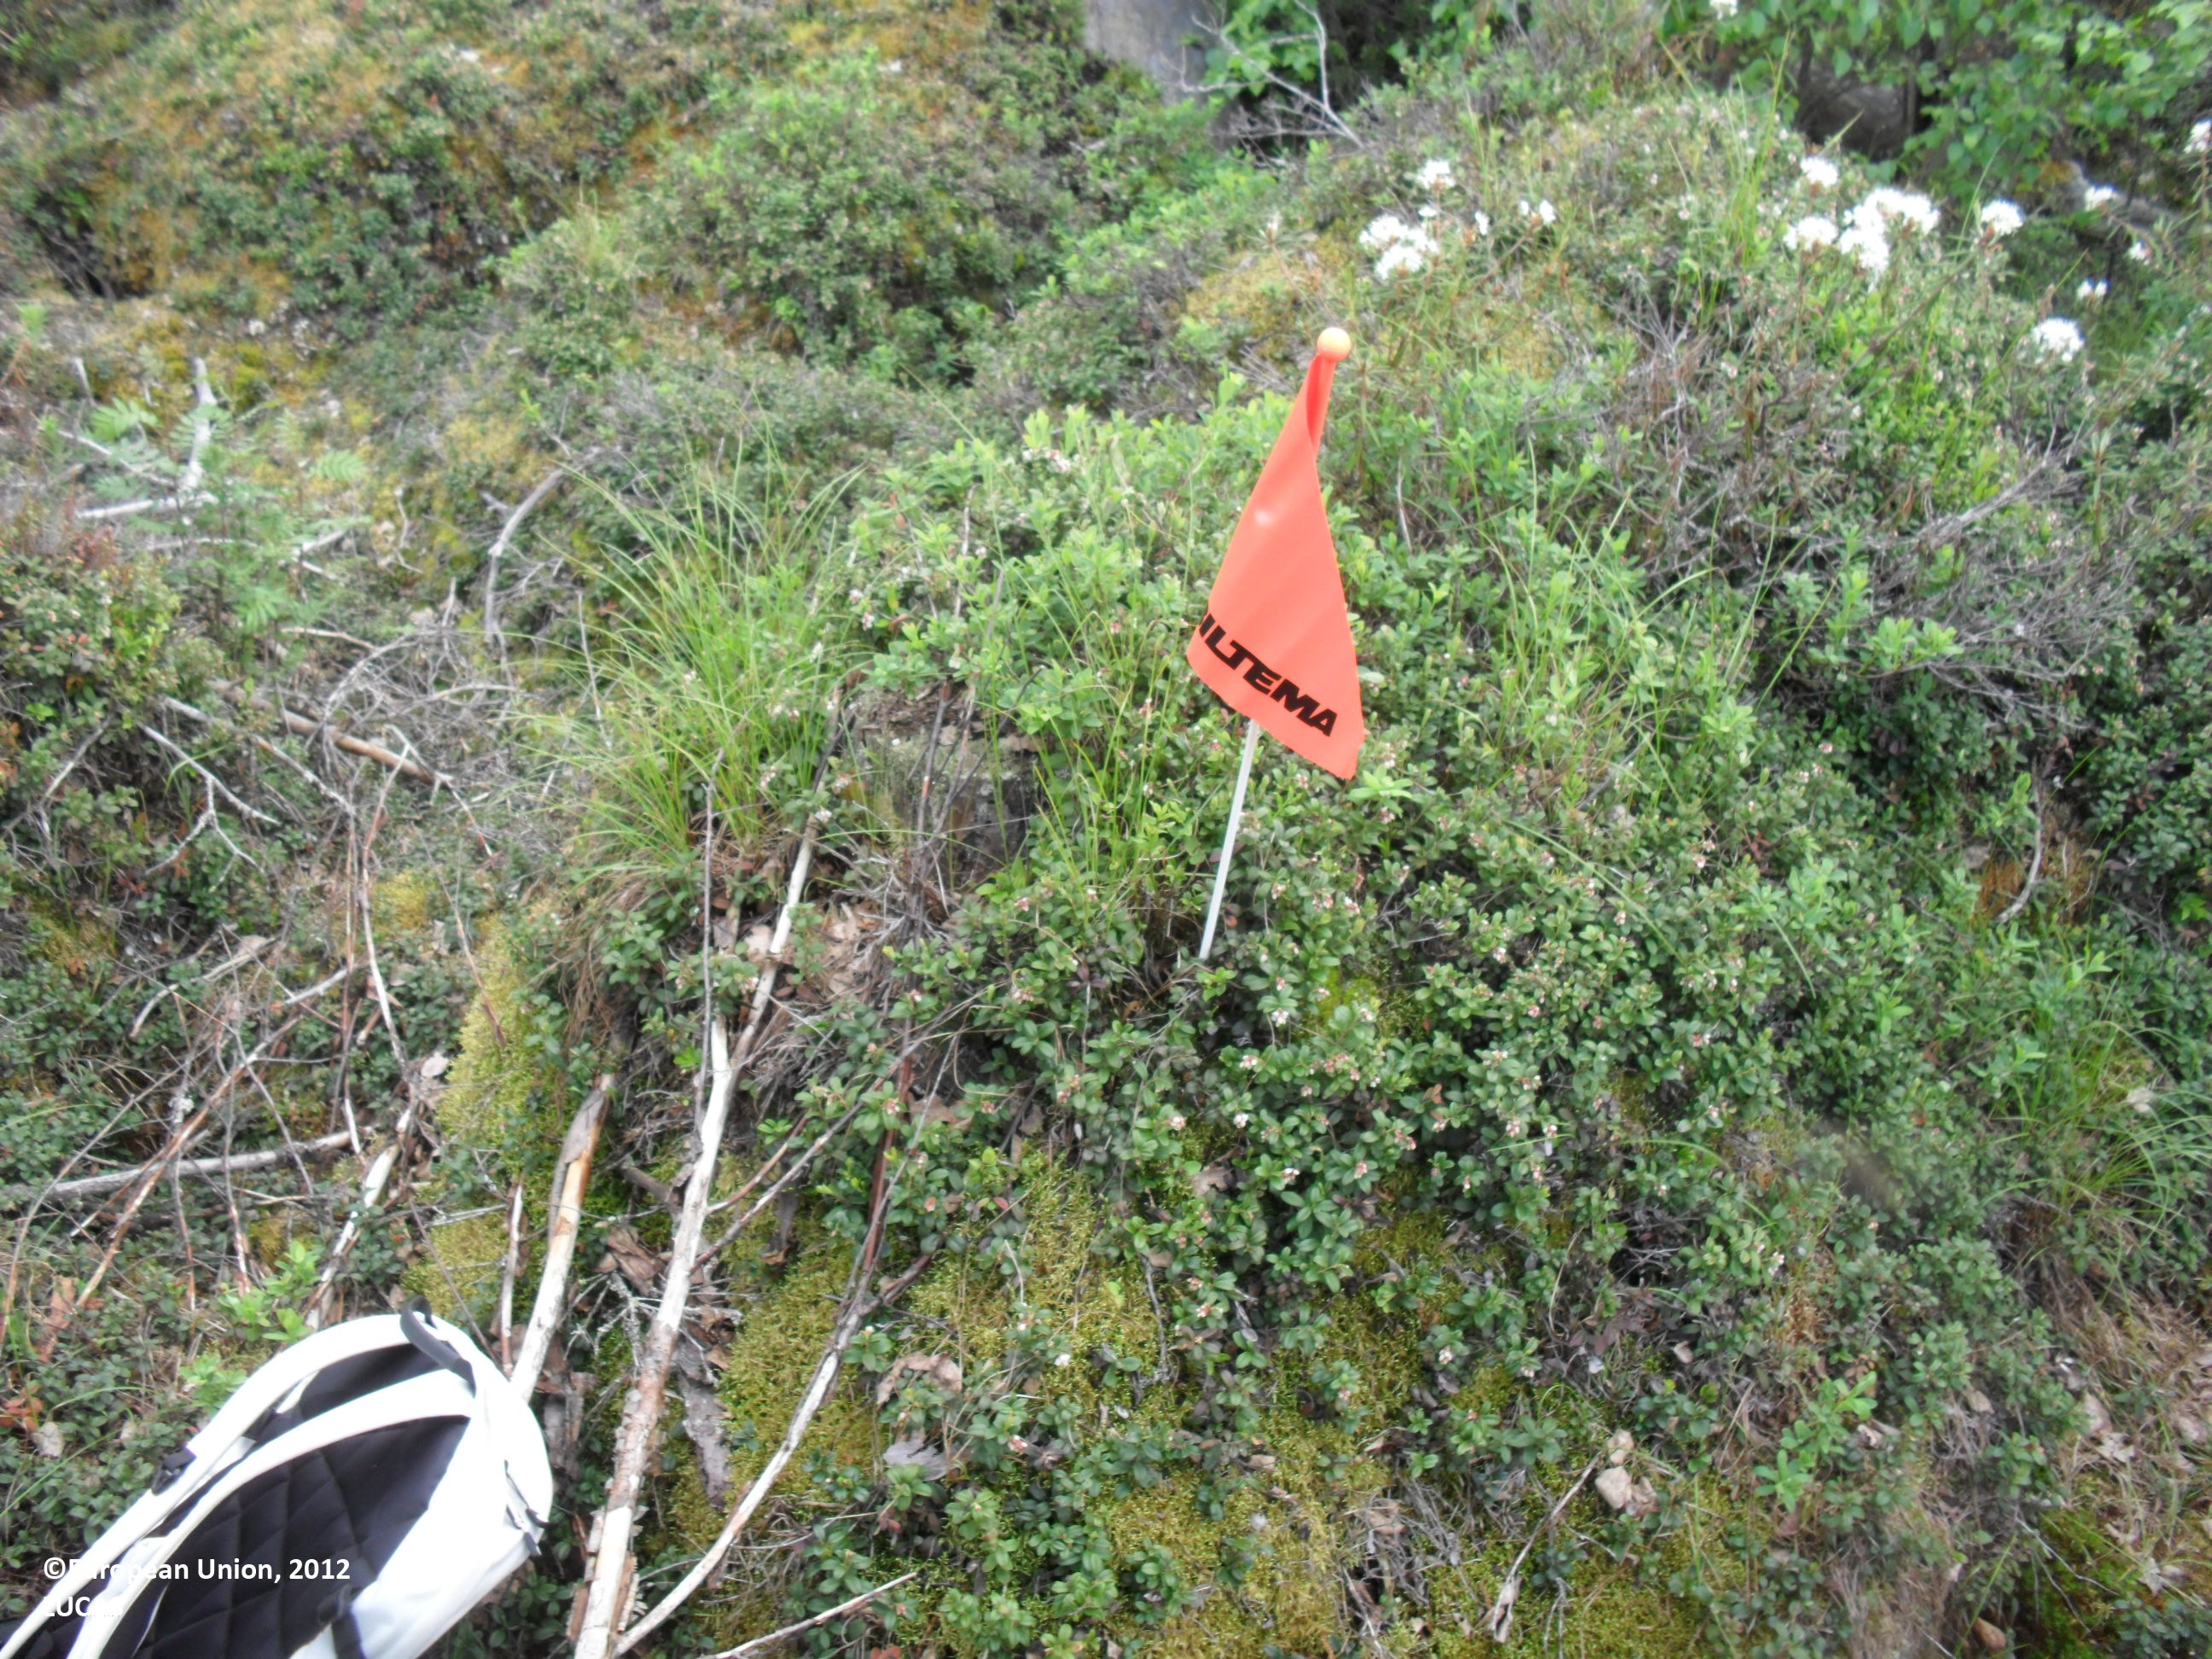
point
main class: Woodland
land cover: Other mixed woodland
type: boreal forest
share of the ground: 10 - 25 %
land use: Forestry
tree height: < 5 m
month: June
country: FI
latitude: 63.2225
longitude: 23.1702
